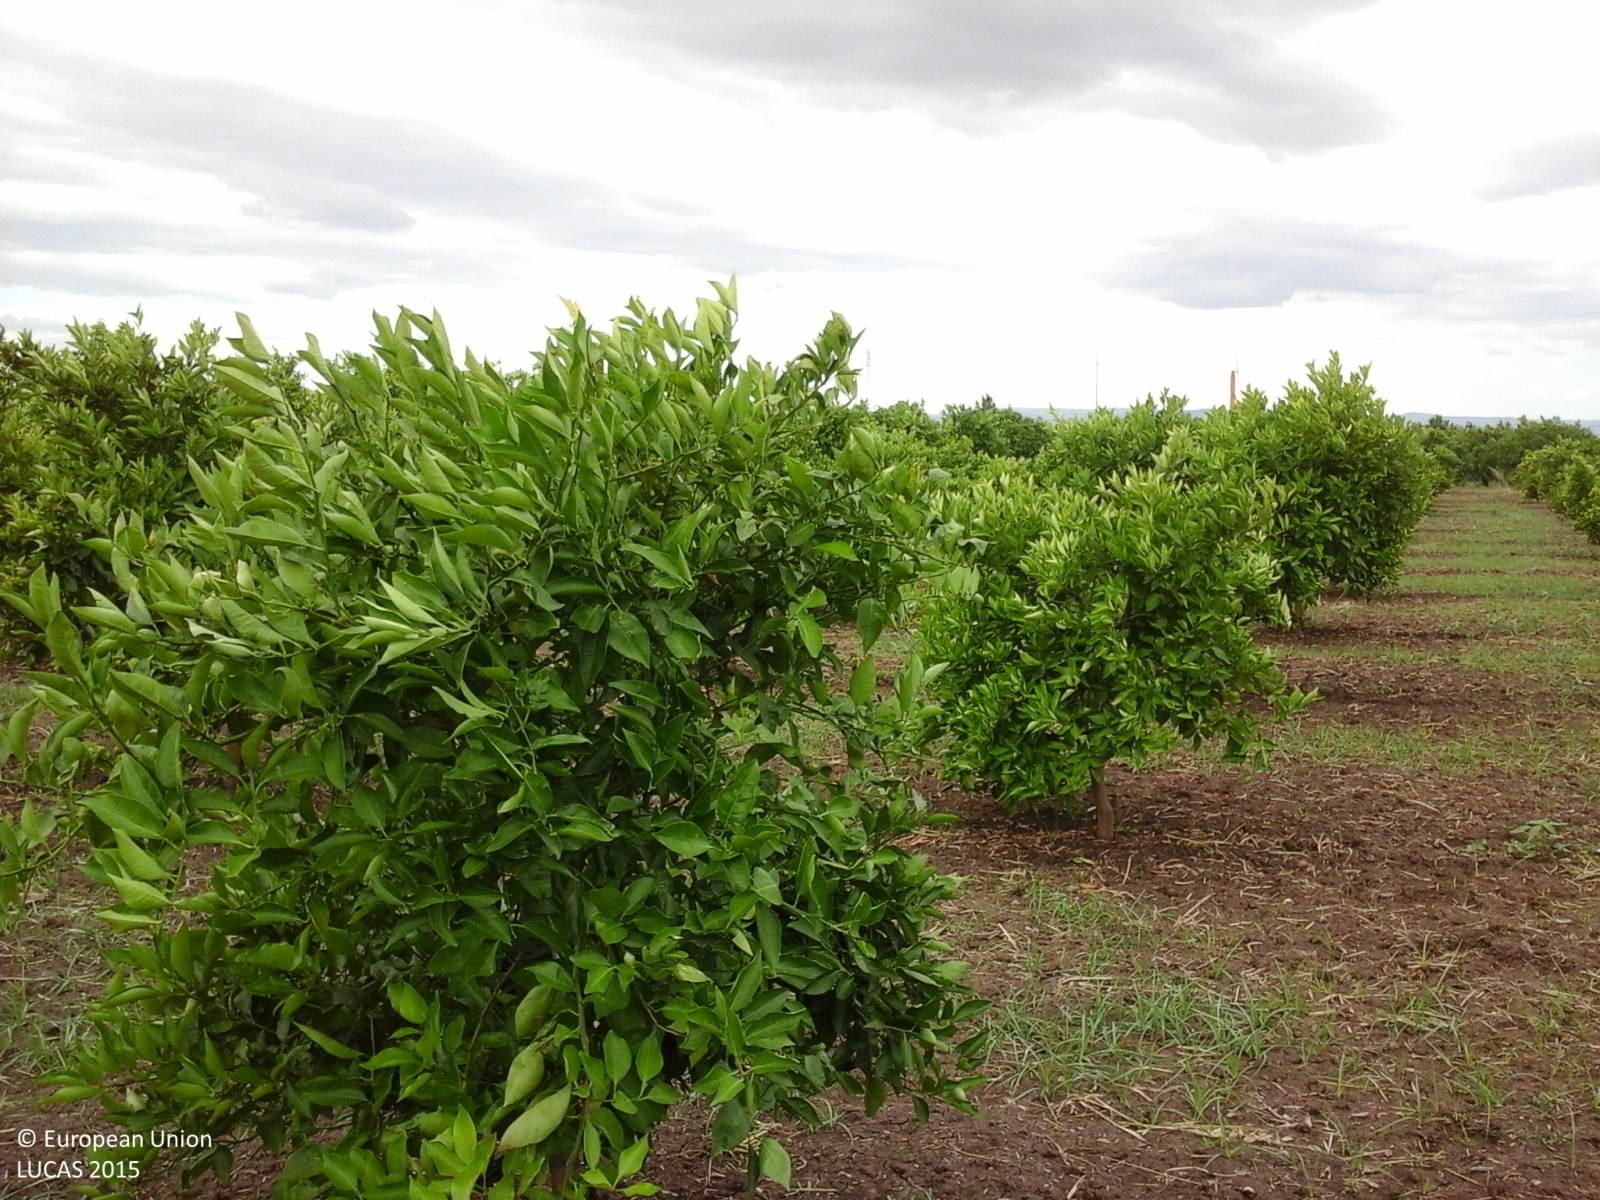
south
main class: Cropland
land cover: Oranges
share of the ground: > 75 %
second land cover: Spontaneously vegetated surfaces
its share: > 75 %
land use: Agriculture (excluding fallow land and kitchen gardens)
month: June
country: IT
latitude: 37.4970
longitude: 14.8399
